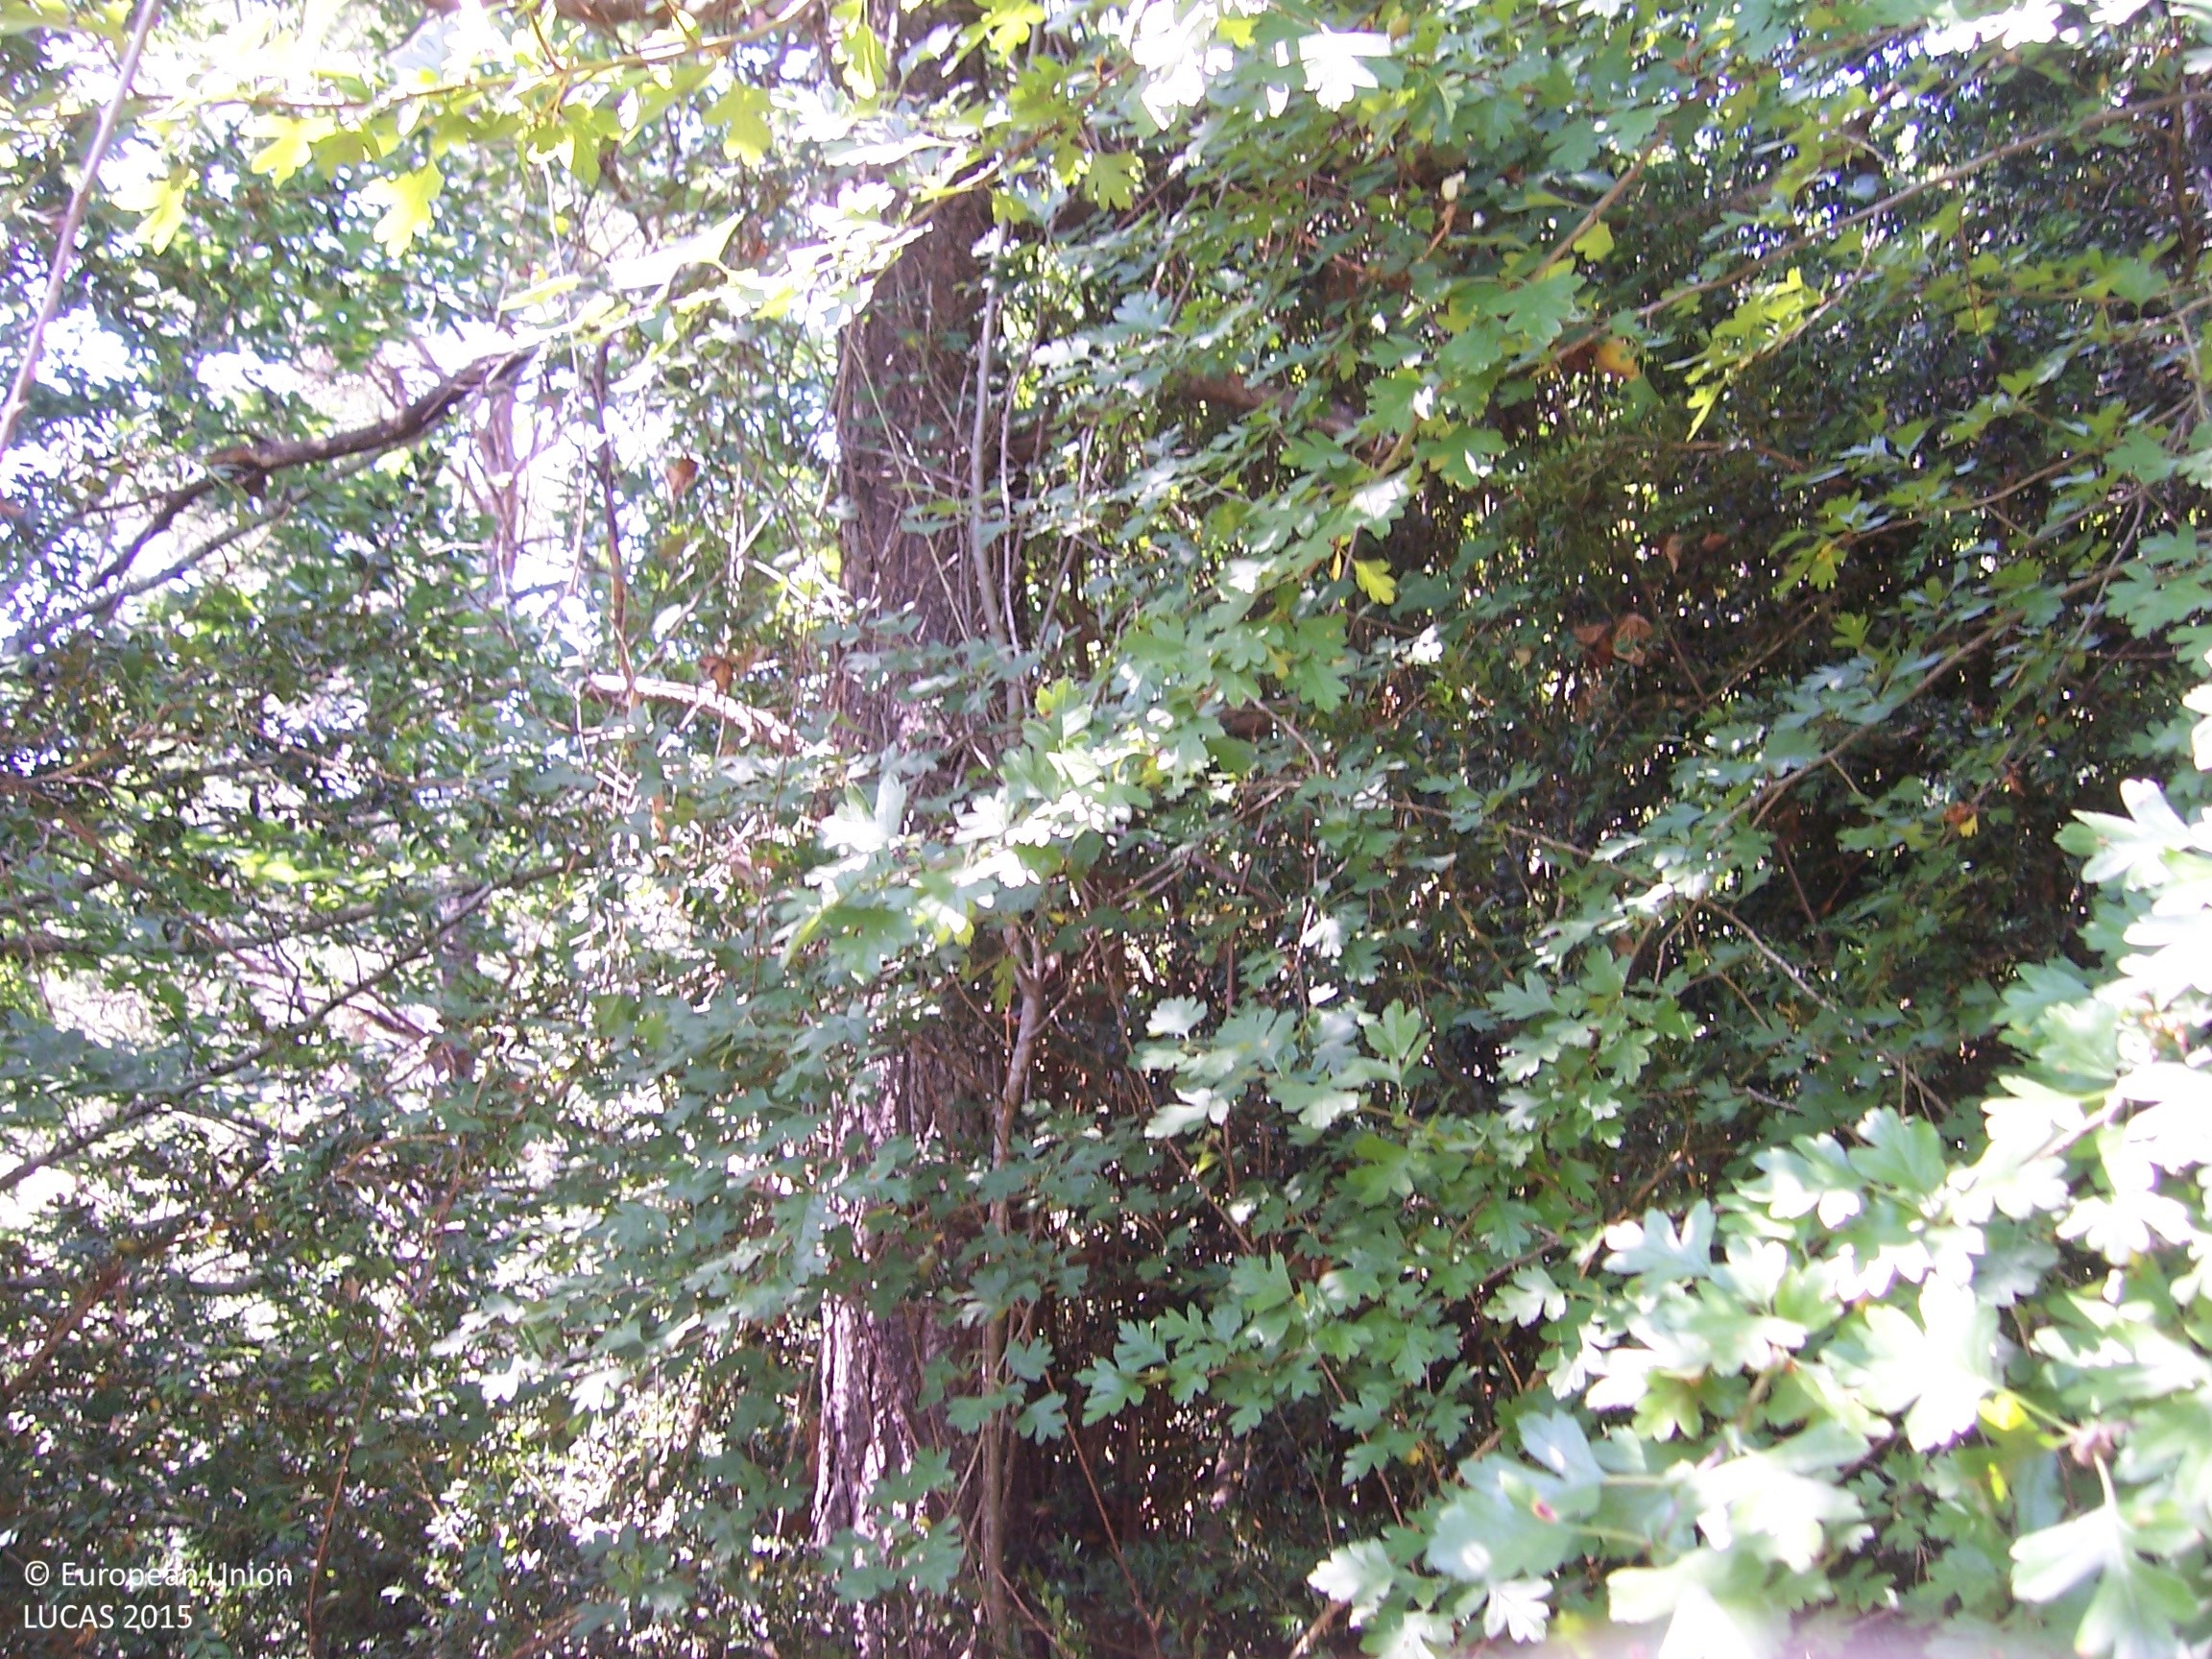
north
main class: Woodland
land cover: Broadleaved woodland
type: beech forest
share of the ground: > 75 %
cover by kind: broadleaved forest trees 75 %, coniferous forest trees 20 %, shrubs 5 %
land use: Forestry
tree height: > 5 m
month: July
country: ES
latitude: 42.8620
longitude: -1.2592
